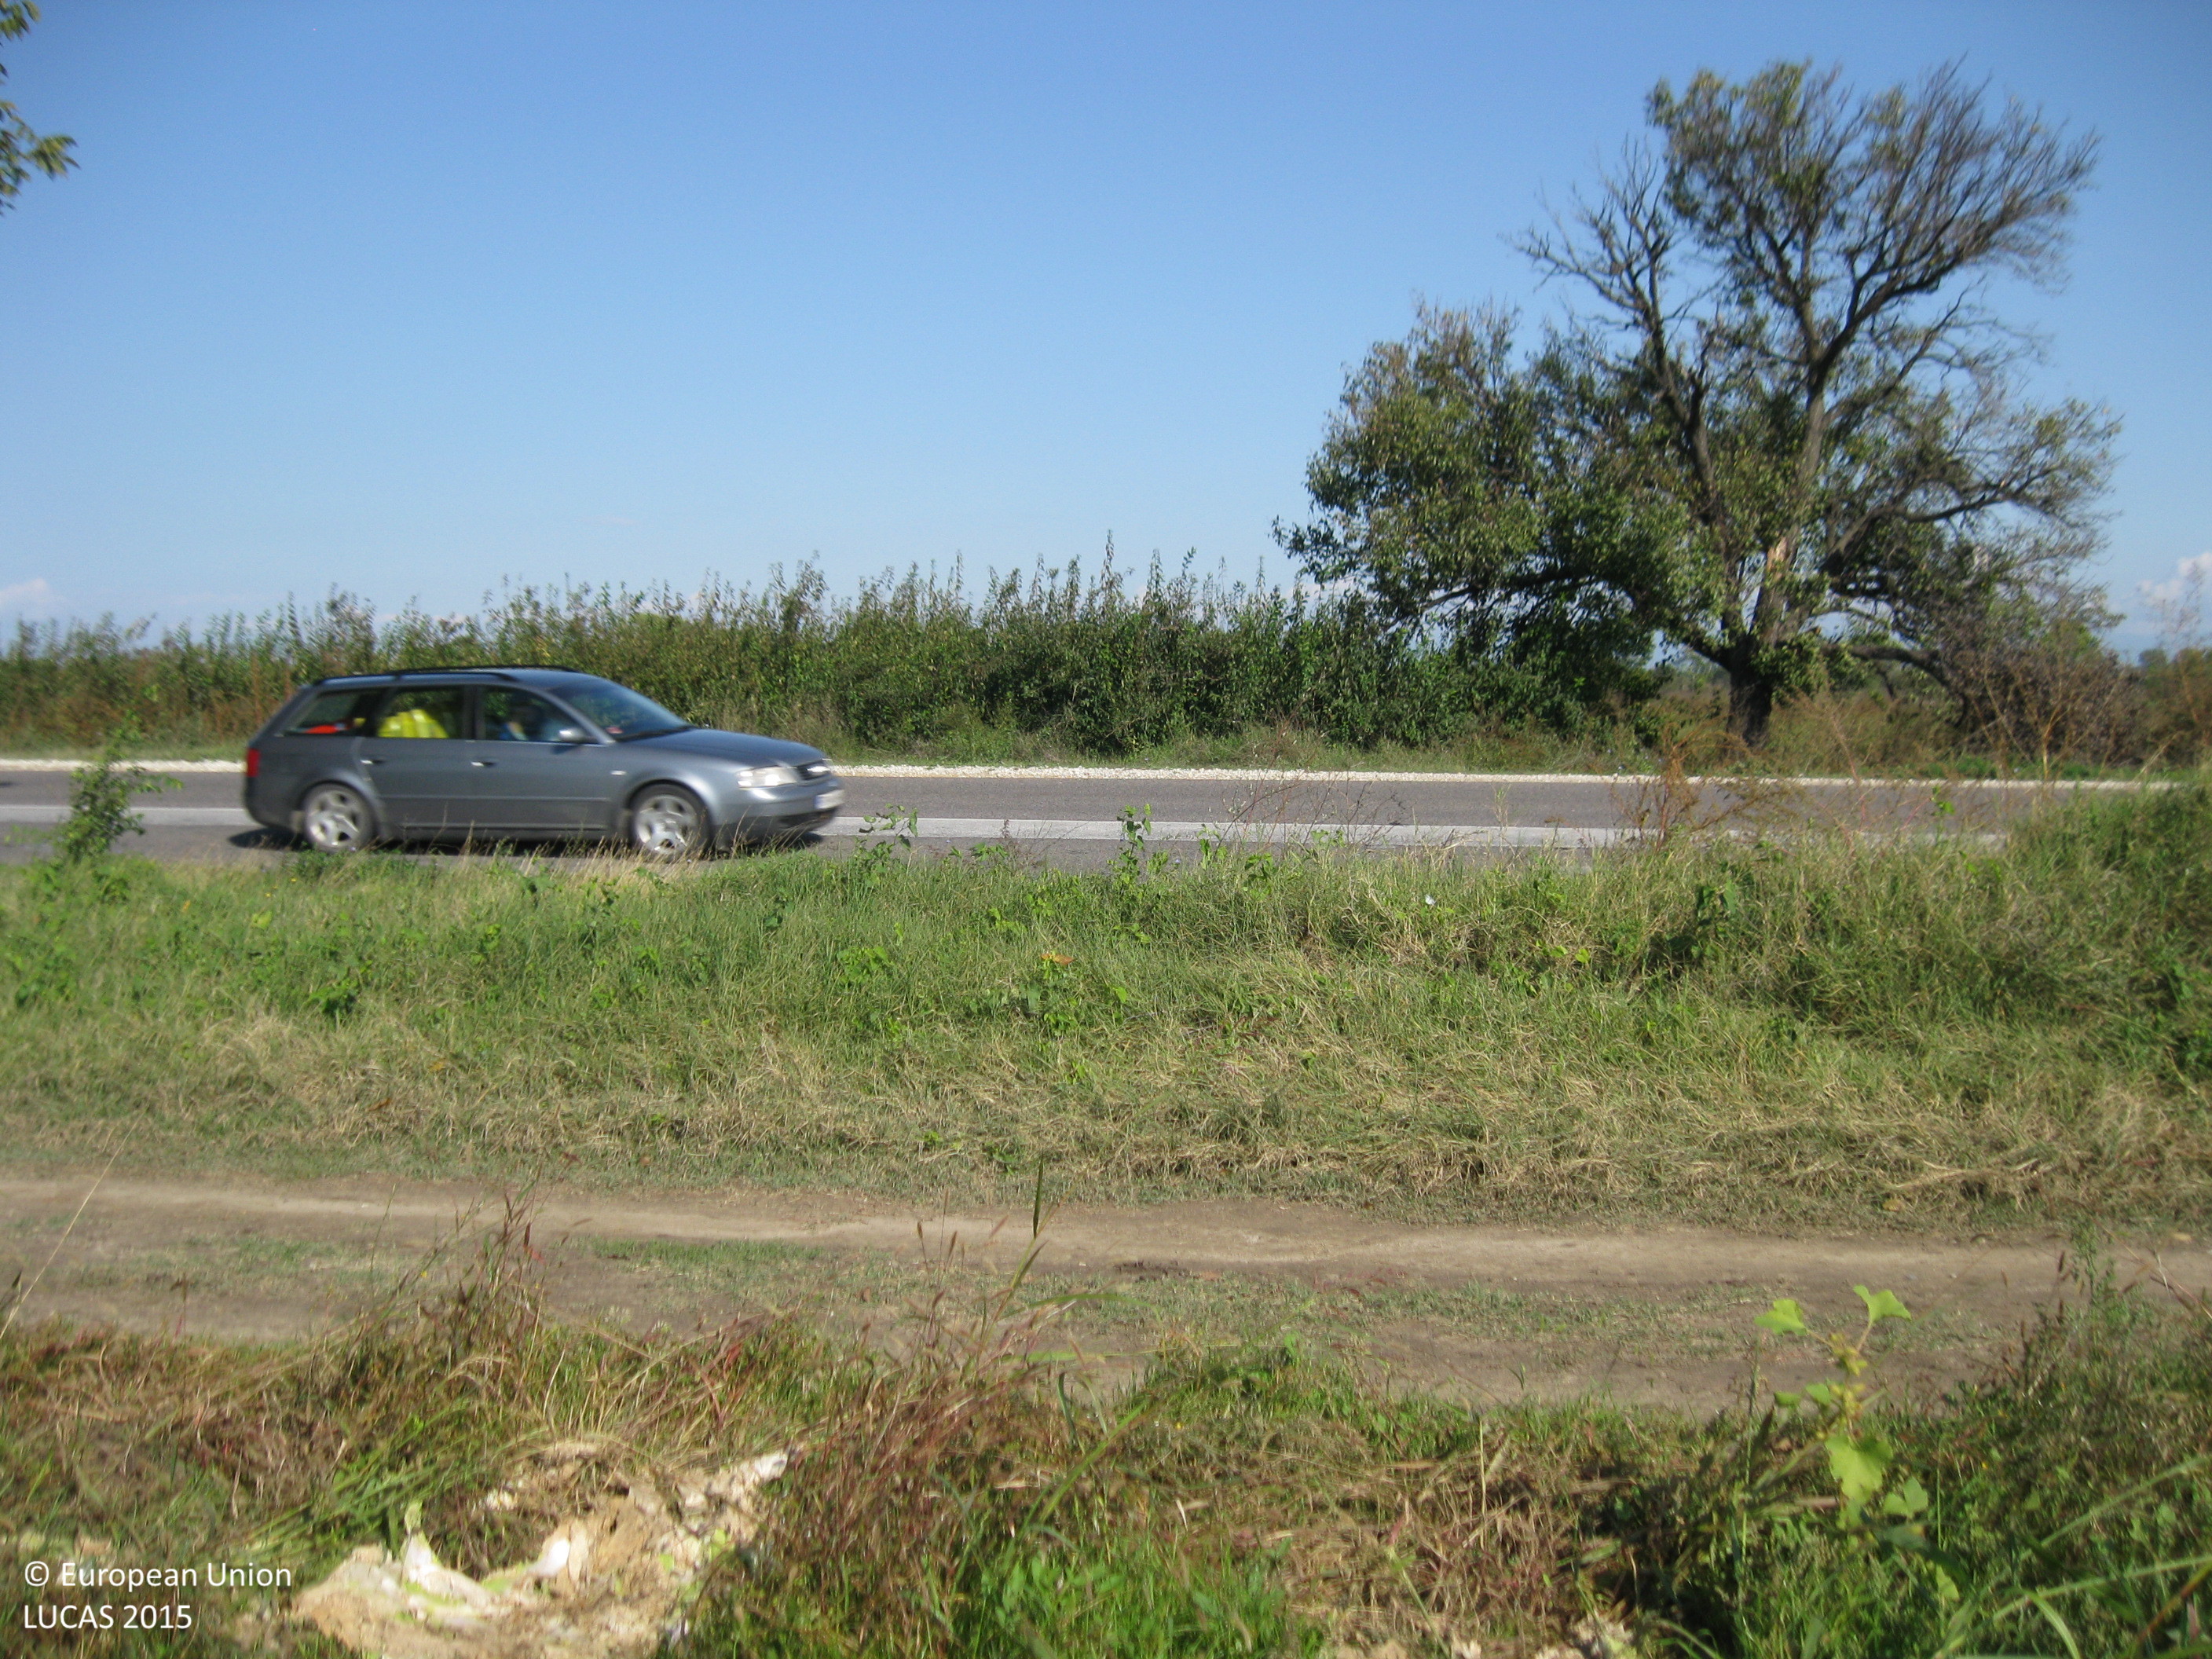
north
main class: Cropland
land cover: Other fresh vegetables
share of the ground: > 75 %
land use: Agriculture (excluding fallow land and kitchen gardens)
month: October
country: BG
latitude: 42.1388
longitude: 24.9737
